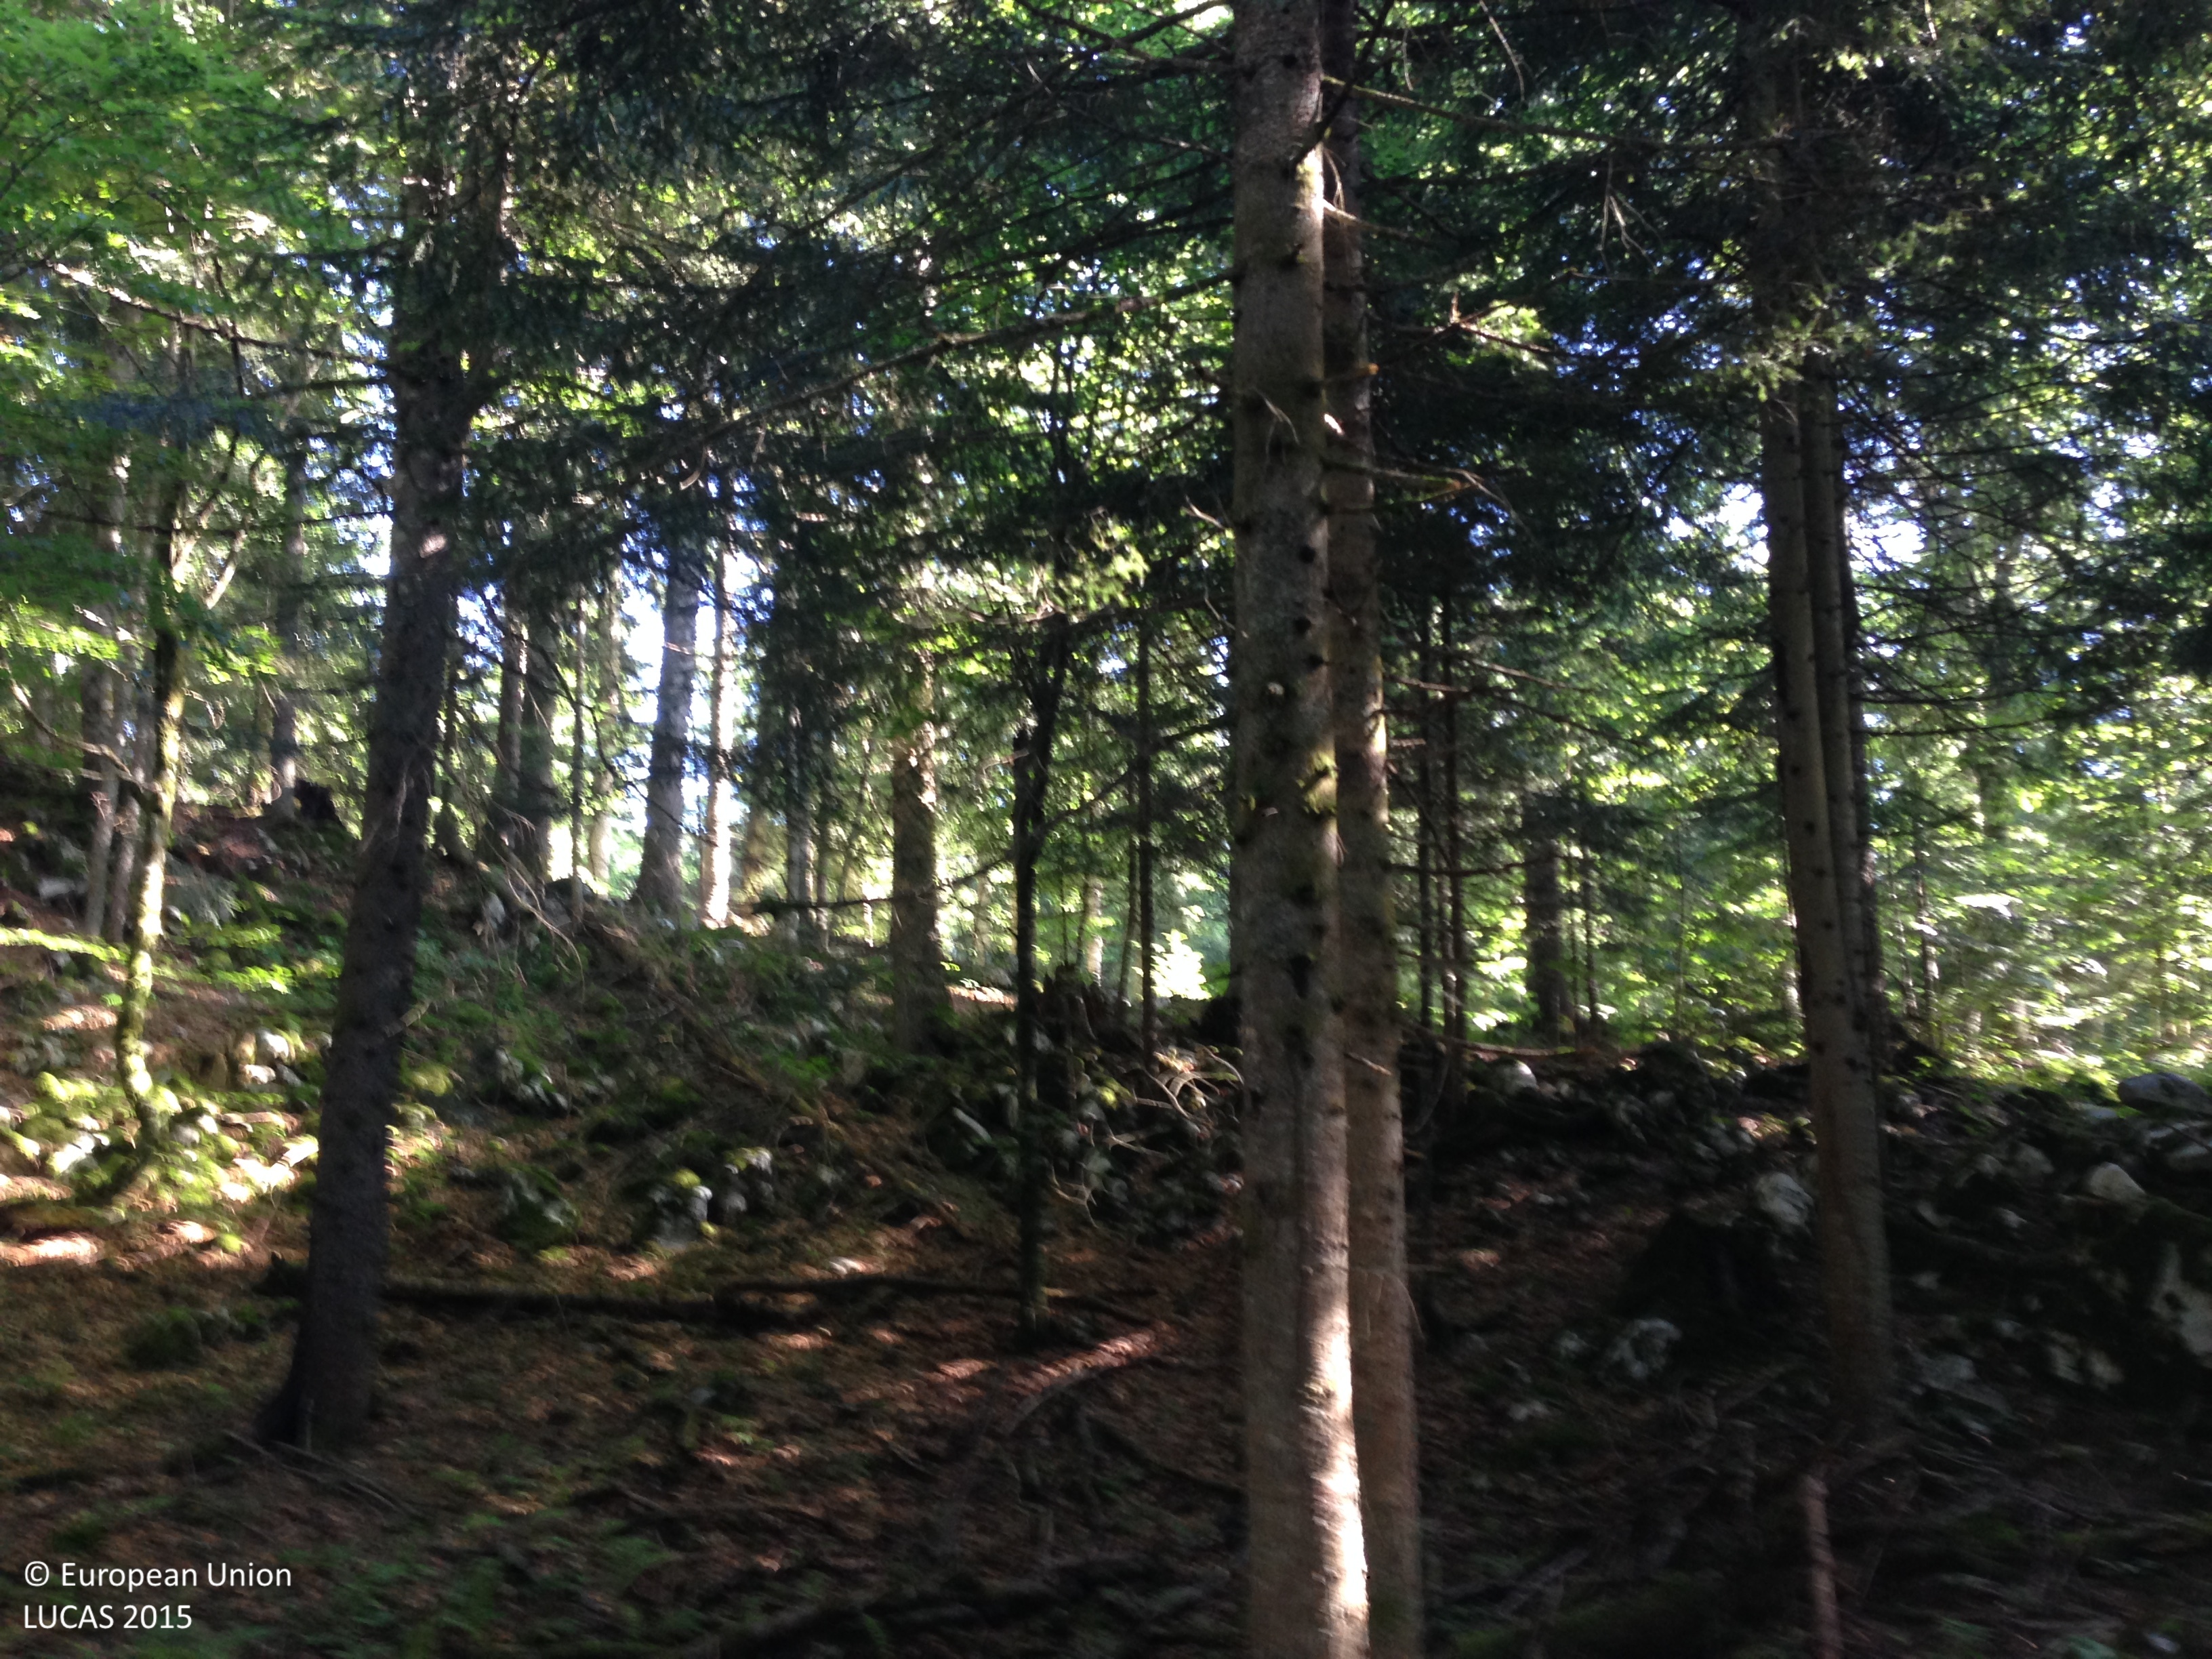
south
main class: Woodland
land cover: Other mixed woodland
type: thermophilous deciduous forest
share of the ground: > 75 %
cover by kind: broadleaved forest trees 45 %, coniferous forest trees 30 %, herbaceous plants 10 %, shrubs 5 %, lichens and mosses 5 %, unconsolidated bare surface 5 %
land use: Forestry
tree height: > 5 m
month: June
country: HR
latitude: 44.6385
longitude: 15.8311
